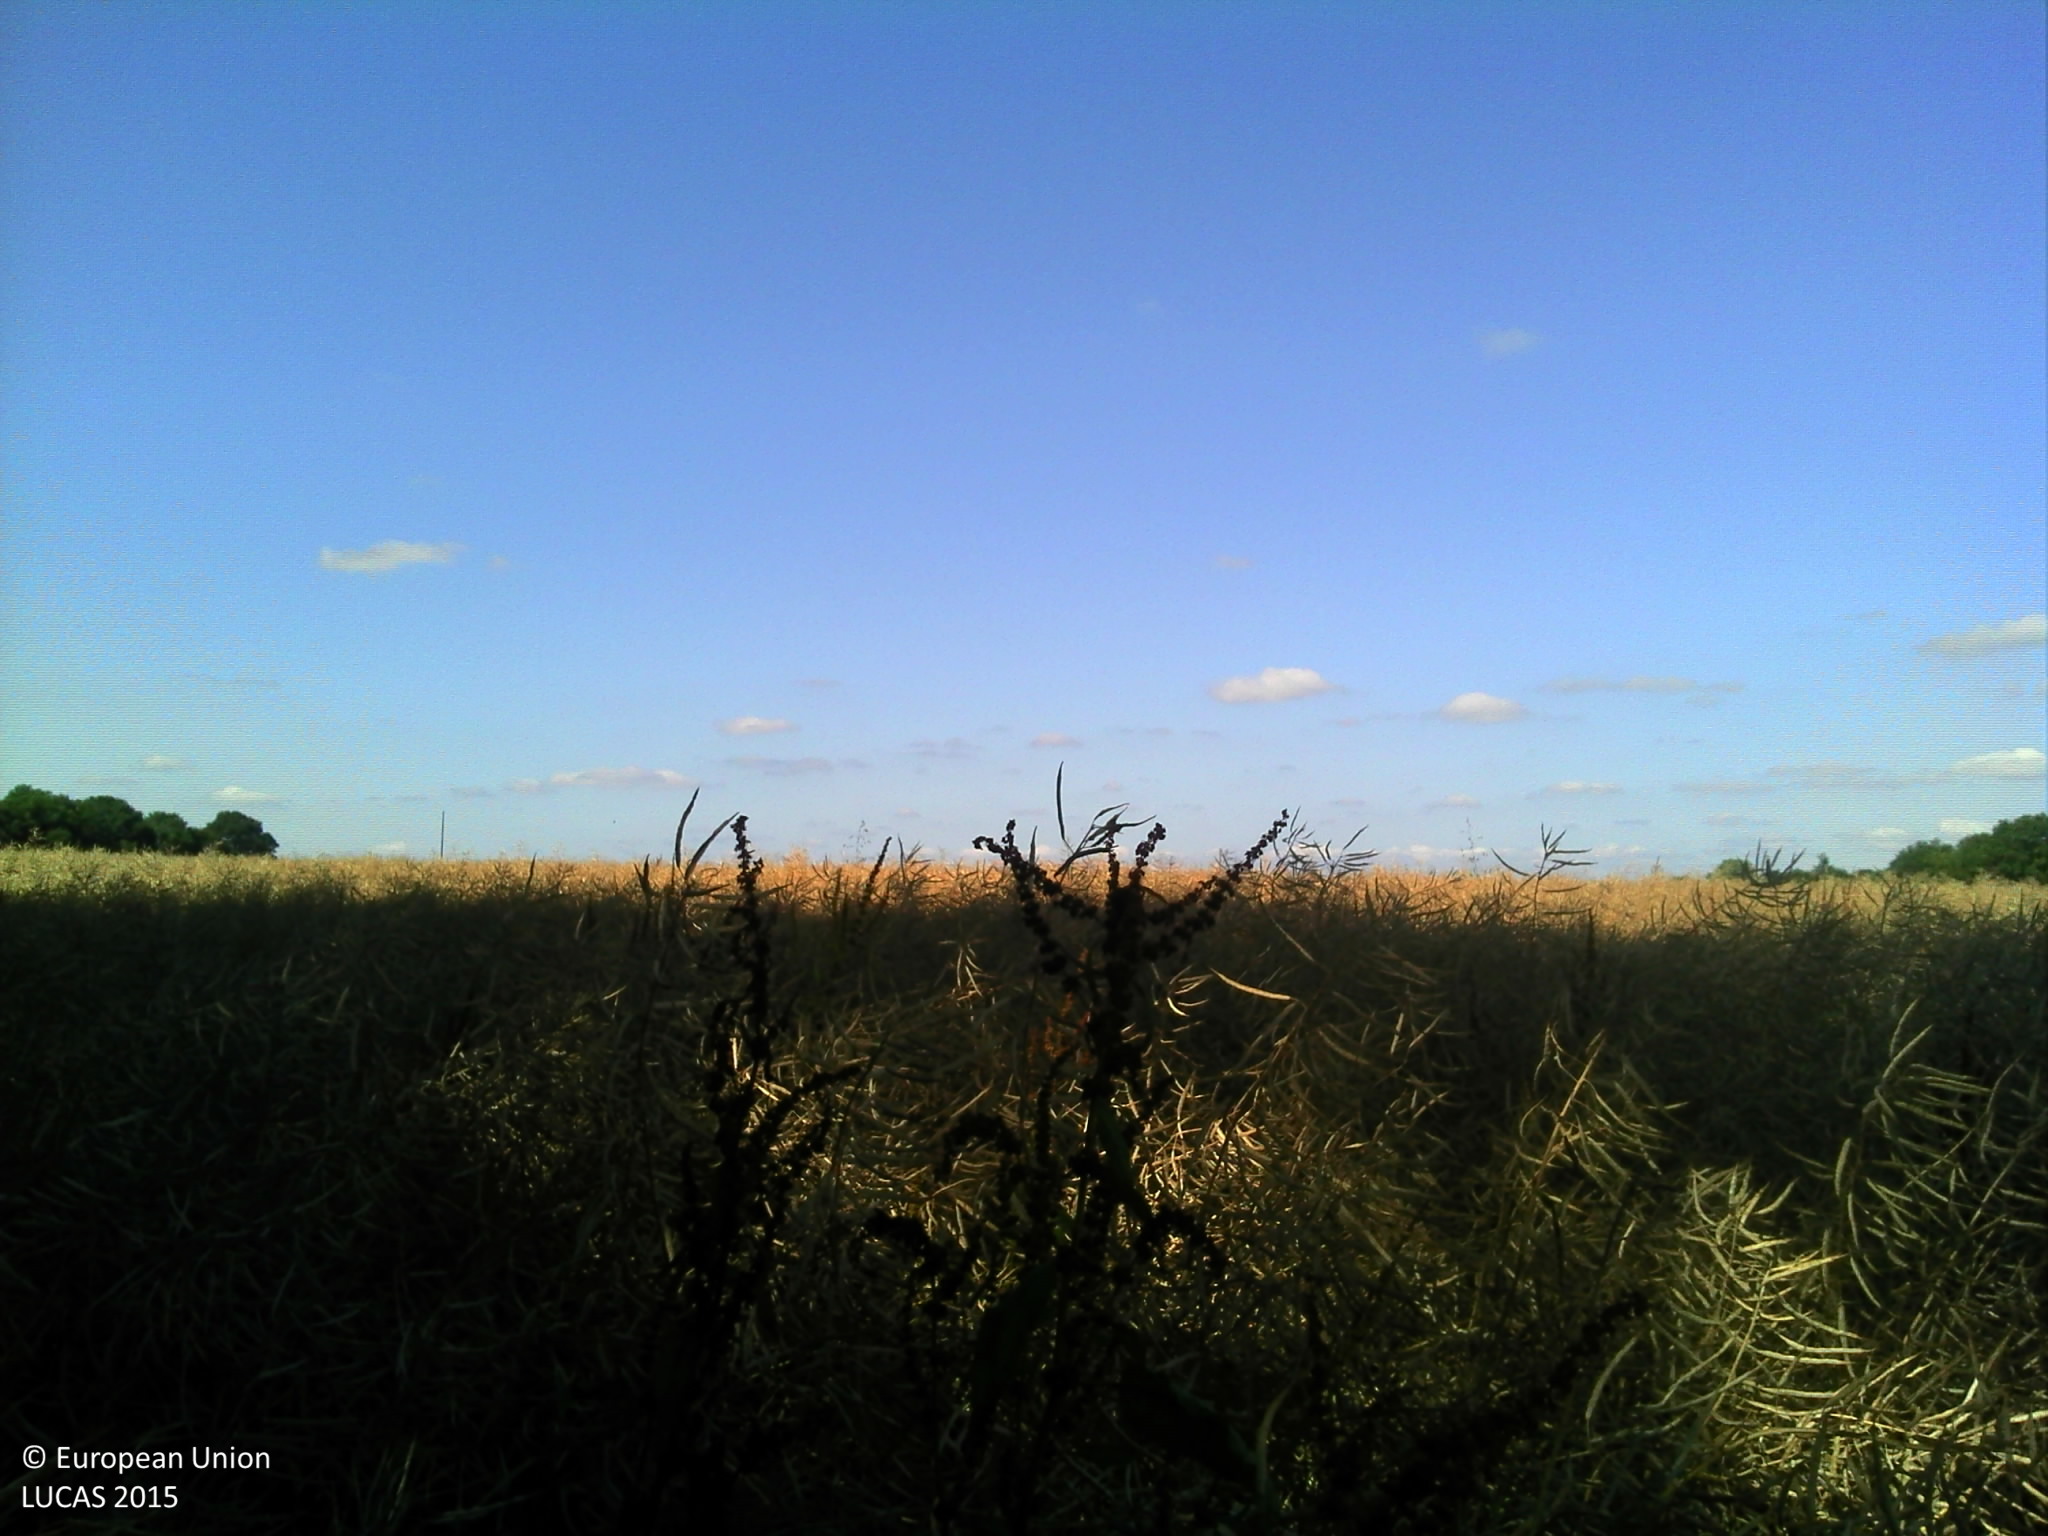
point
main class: Cropland
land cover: Rape and turnip rape
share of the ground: > 75 %
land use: Agriculture (excluding fallow land and kitchen gardens)
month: July
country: FR
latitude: 47.9294
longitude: 0.5953
